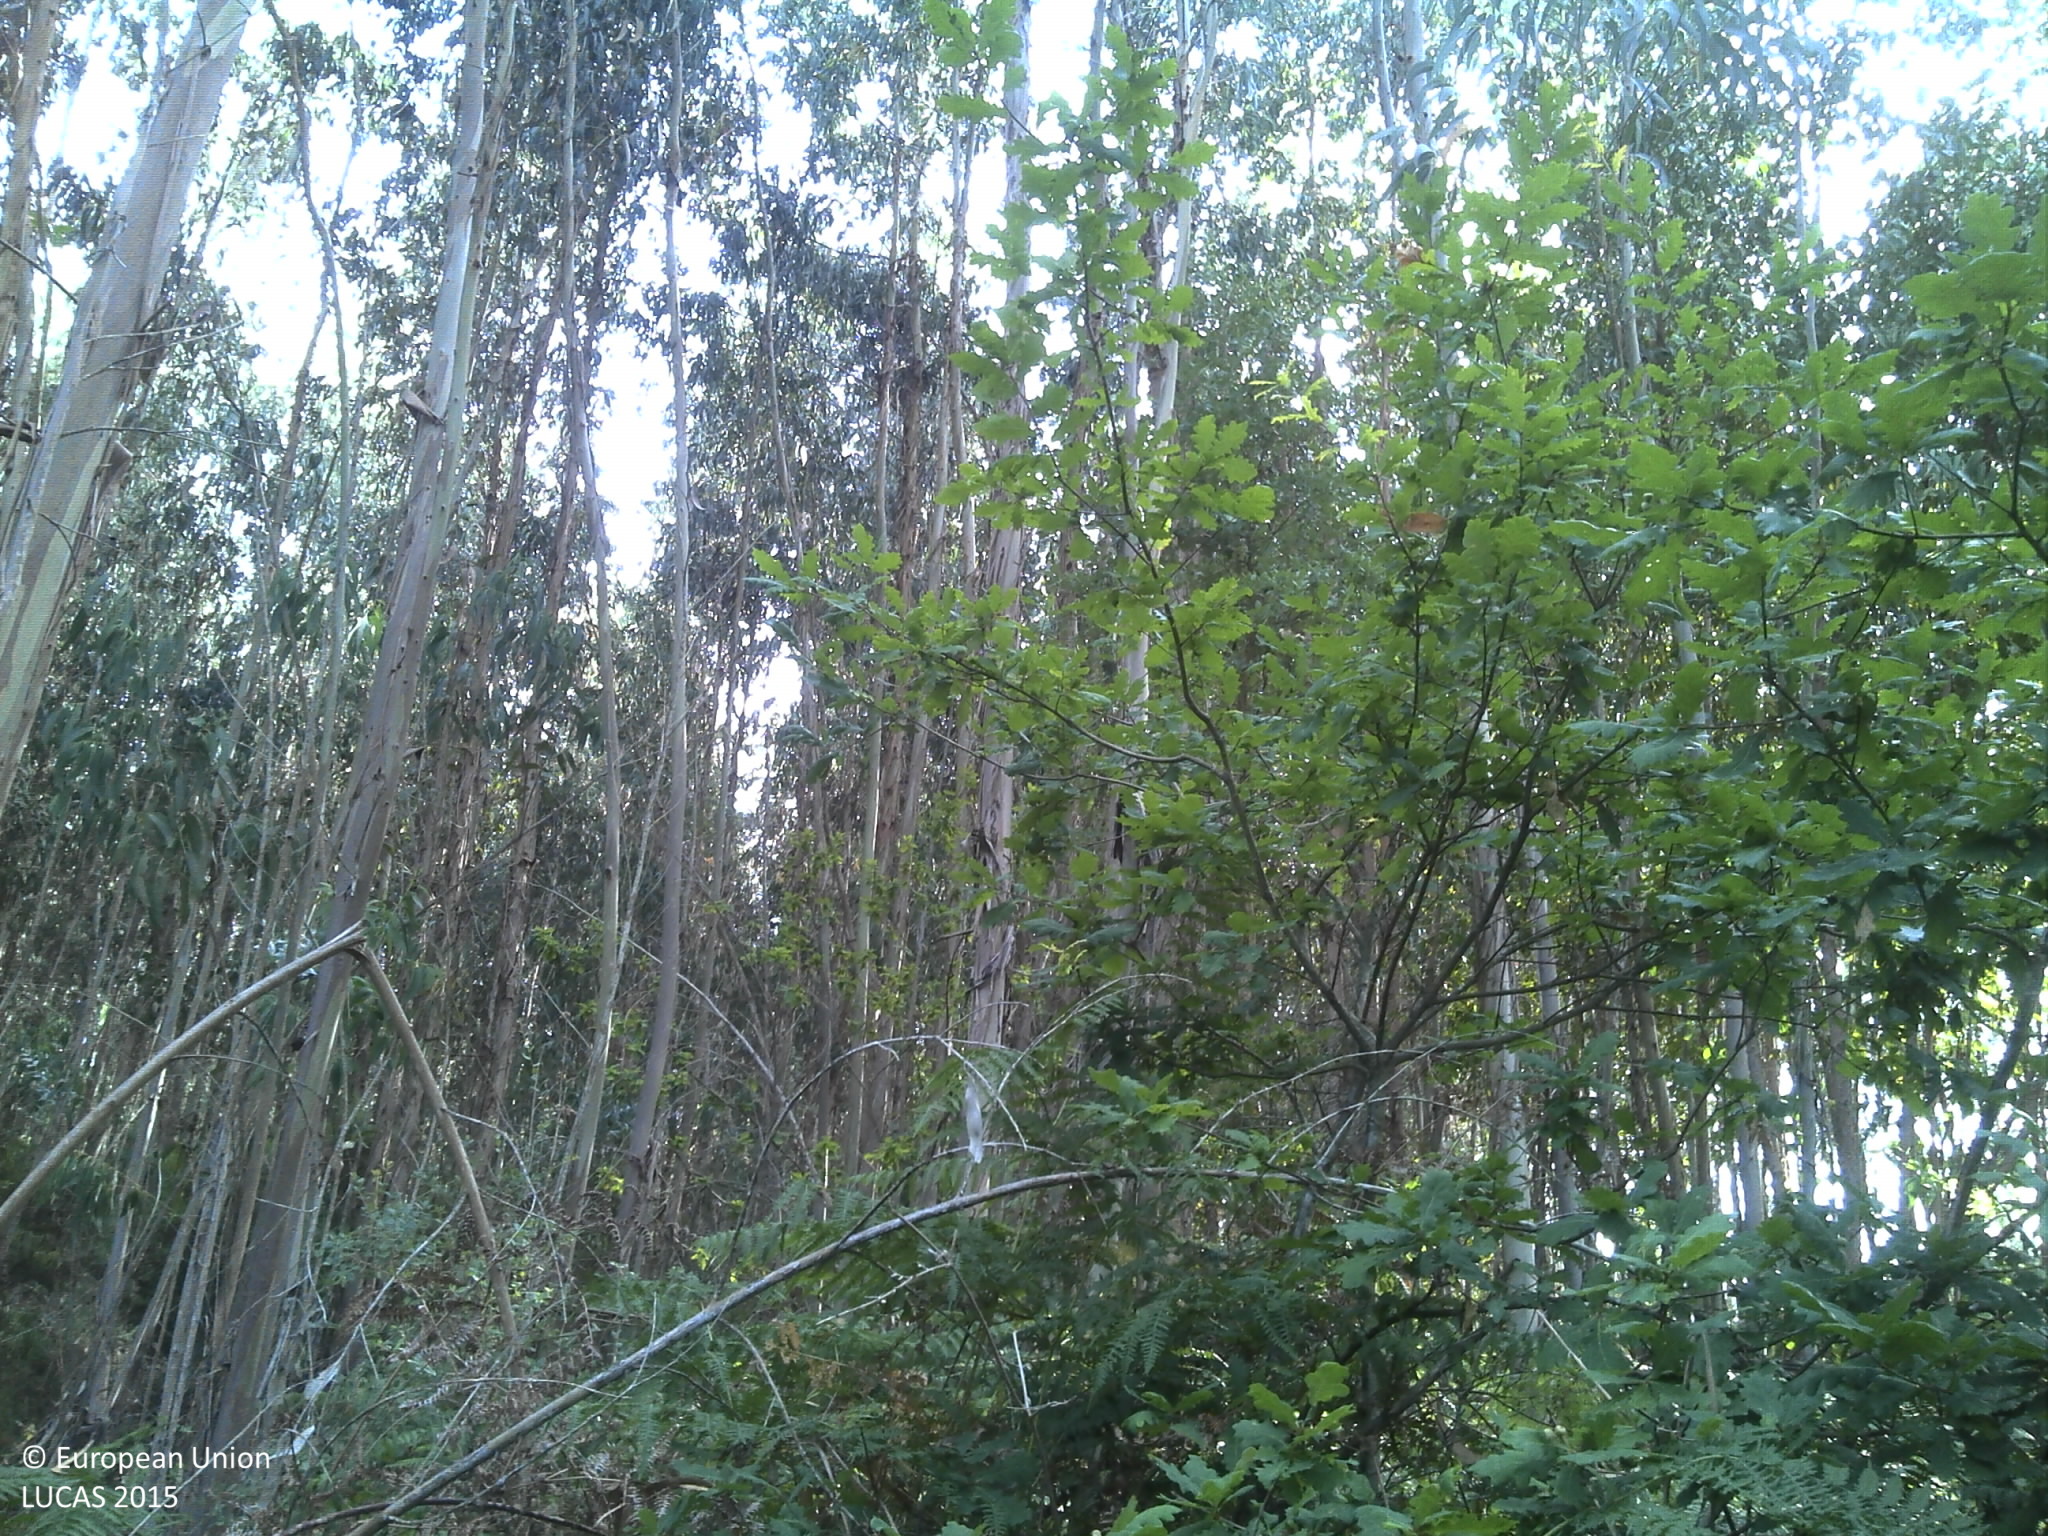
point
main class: Woodland
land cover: Broadleaved woodland
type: exotic forest
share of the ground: 50 - 75 %
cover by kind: broadleaved forest trees 75 %, shrubs 20 %, unconsolidated bare surface 5 %
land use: Forestry
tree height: > 5 m
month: July
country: PT
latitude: 40.2767
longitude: -8.1536
